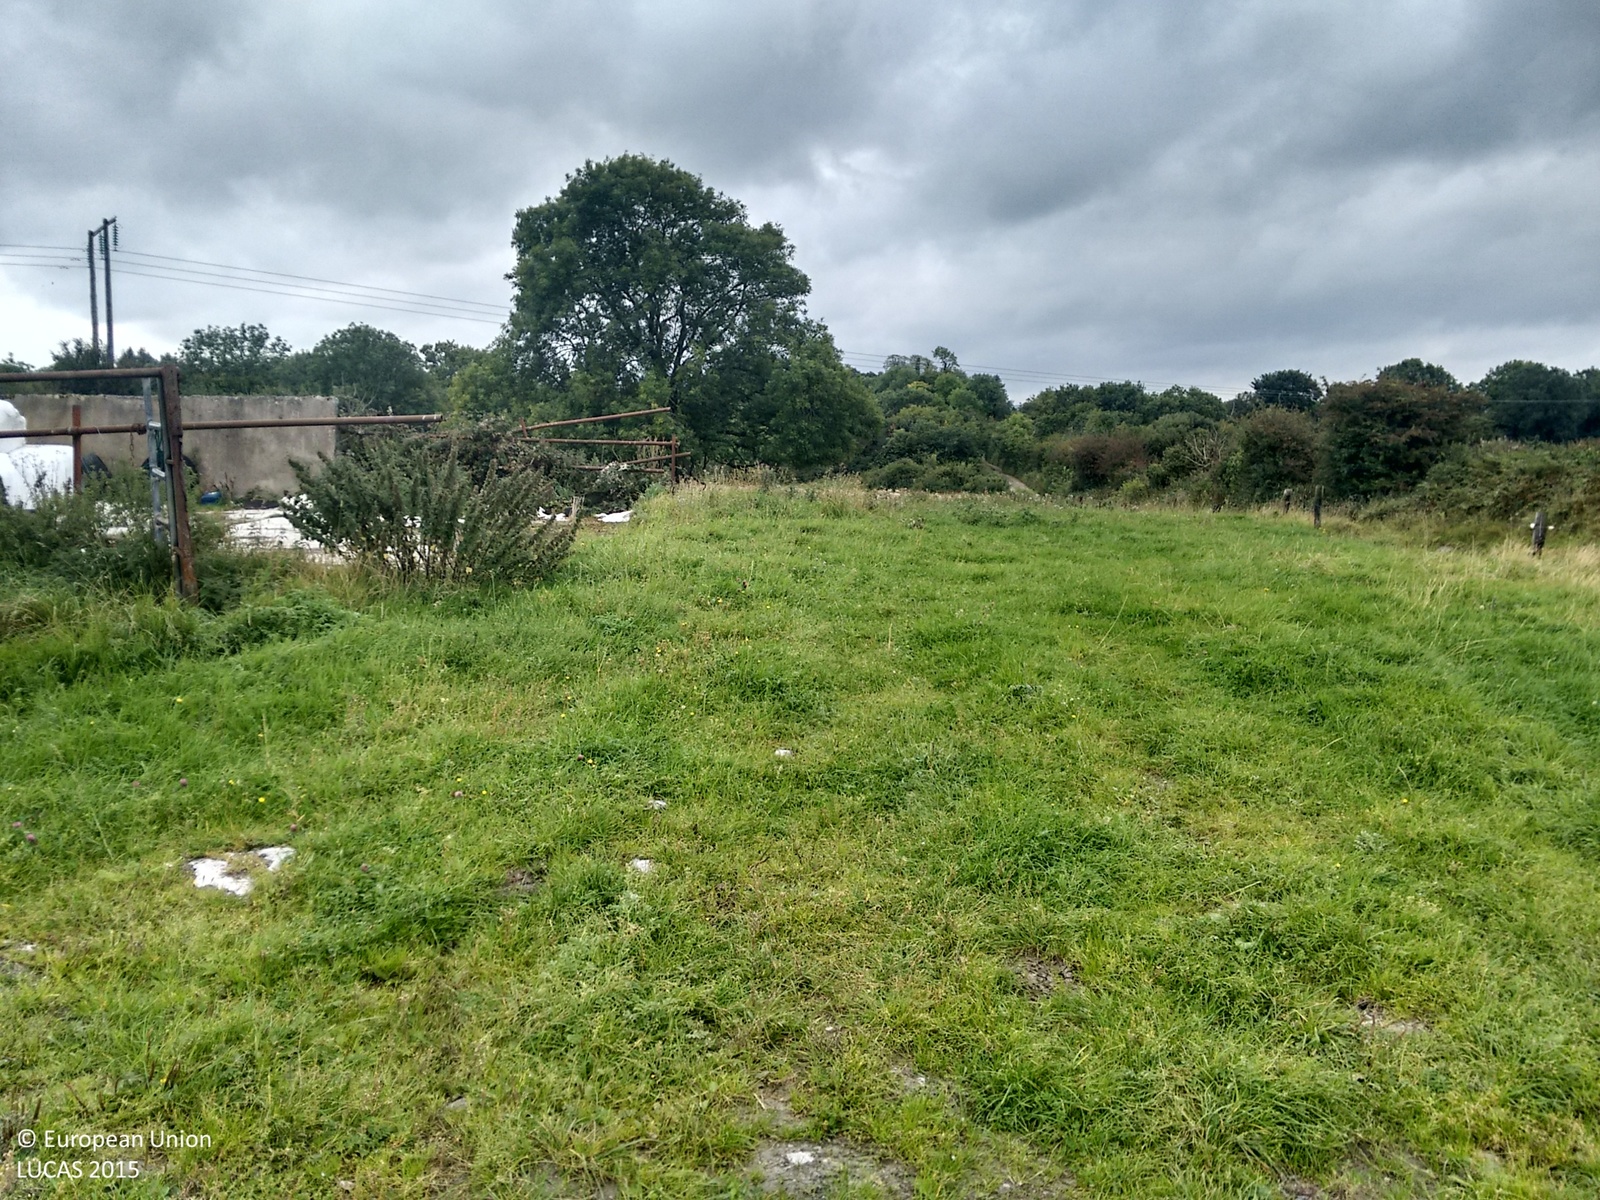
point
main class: Grassland
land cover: Grassland with sparse tree/shrub cover
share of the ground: > 75 %
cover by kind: herbaceous plants 95 %, broadleaved forest trees 5 %
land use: Agriculture (excluding fallow land and kitchen gardens)
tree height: > 5 m
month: September
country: IE
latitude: 52.5703
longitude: -9.0566
